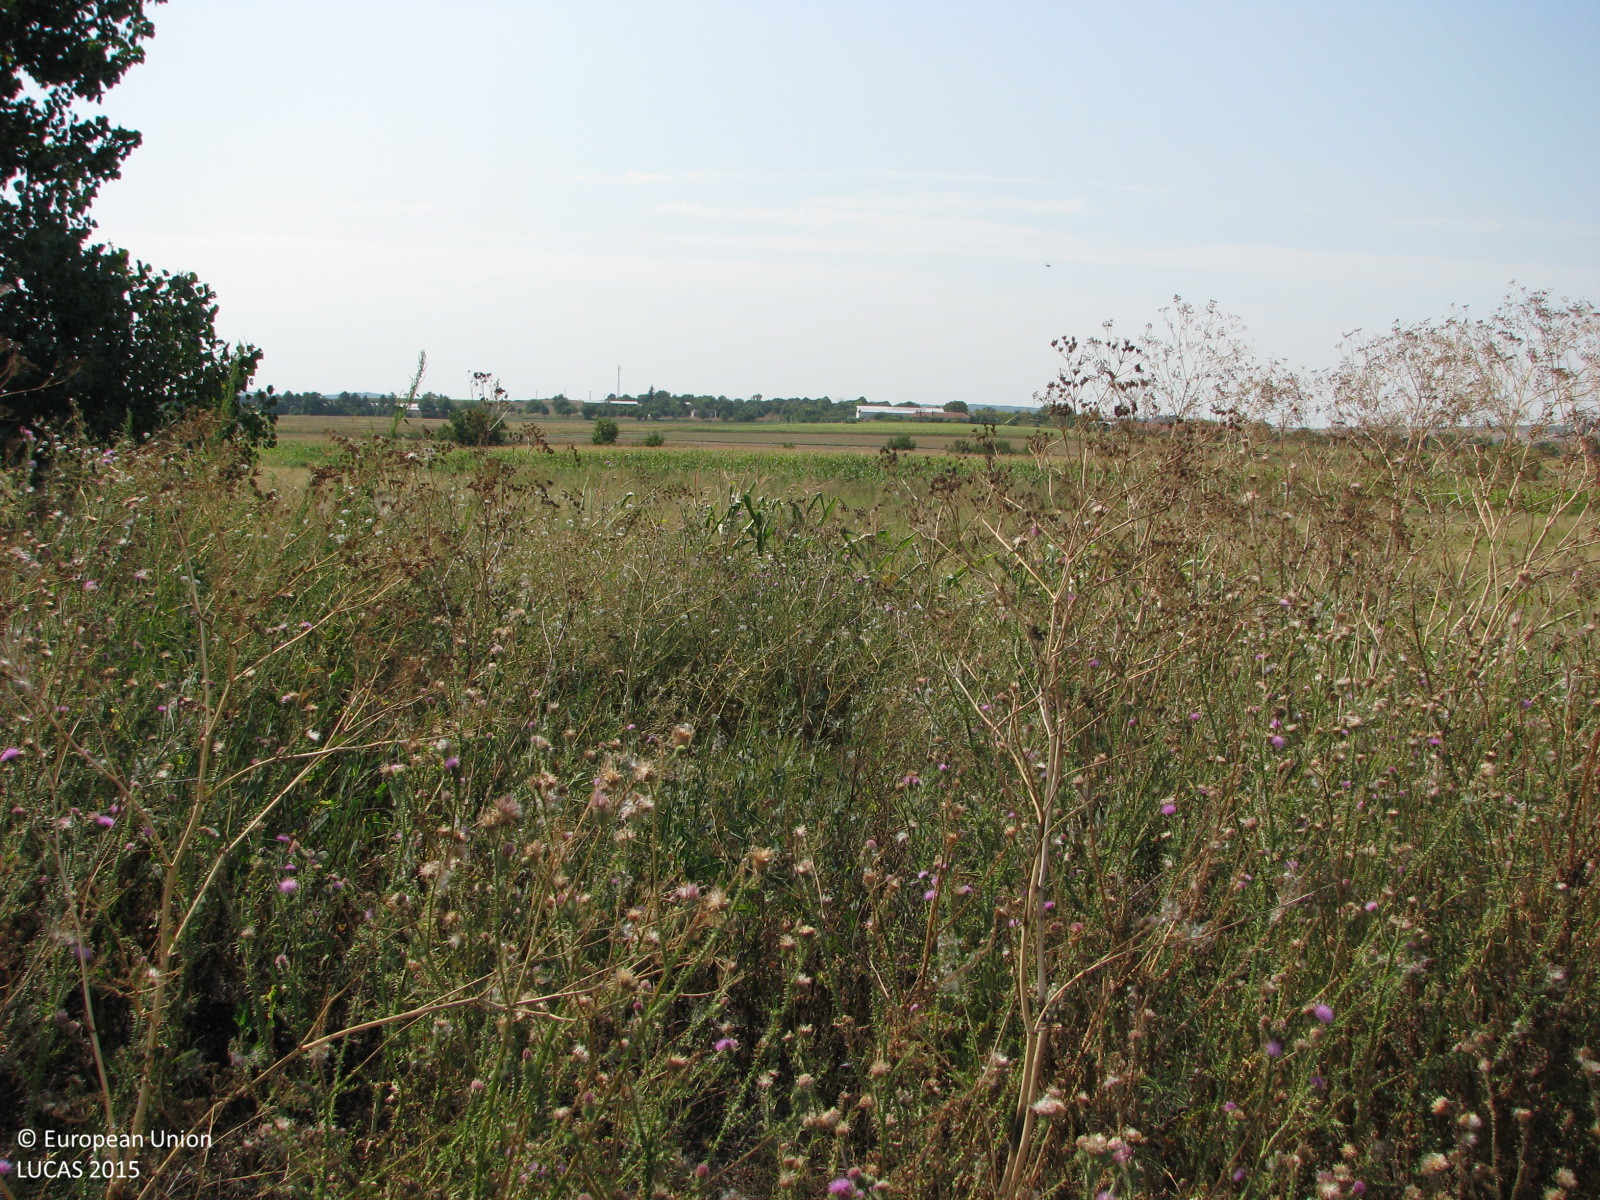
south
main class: Grassland
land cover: Grassland with sparse tree/shrub cover
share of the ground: > 75 %
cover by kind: herbaceous plants 95 %, broadleaved forest trees 5 %
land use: Semi-natural and natural areas not in use
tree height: > 5 m
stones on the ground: < 10 %
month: August
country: BG
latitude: 42.4067
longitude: 26.3075
